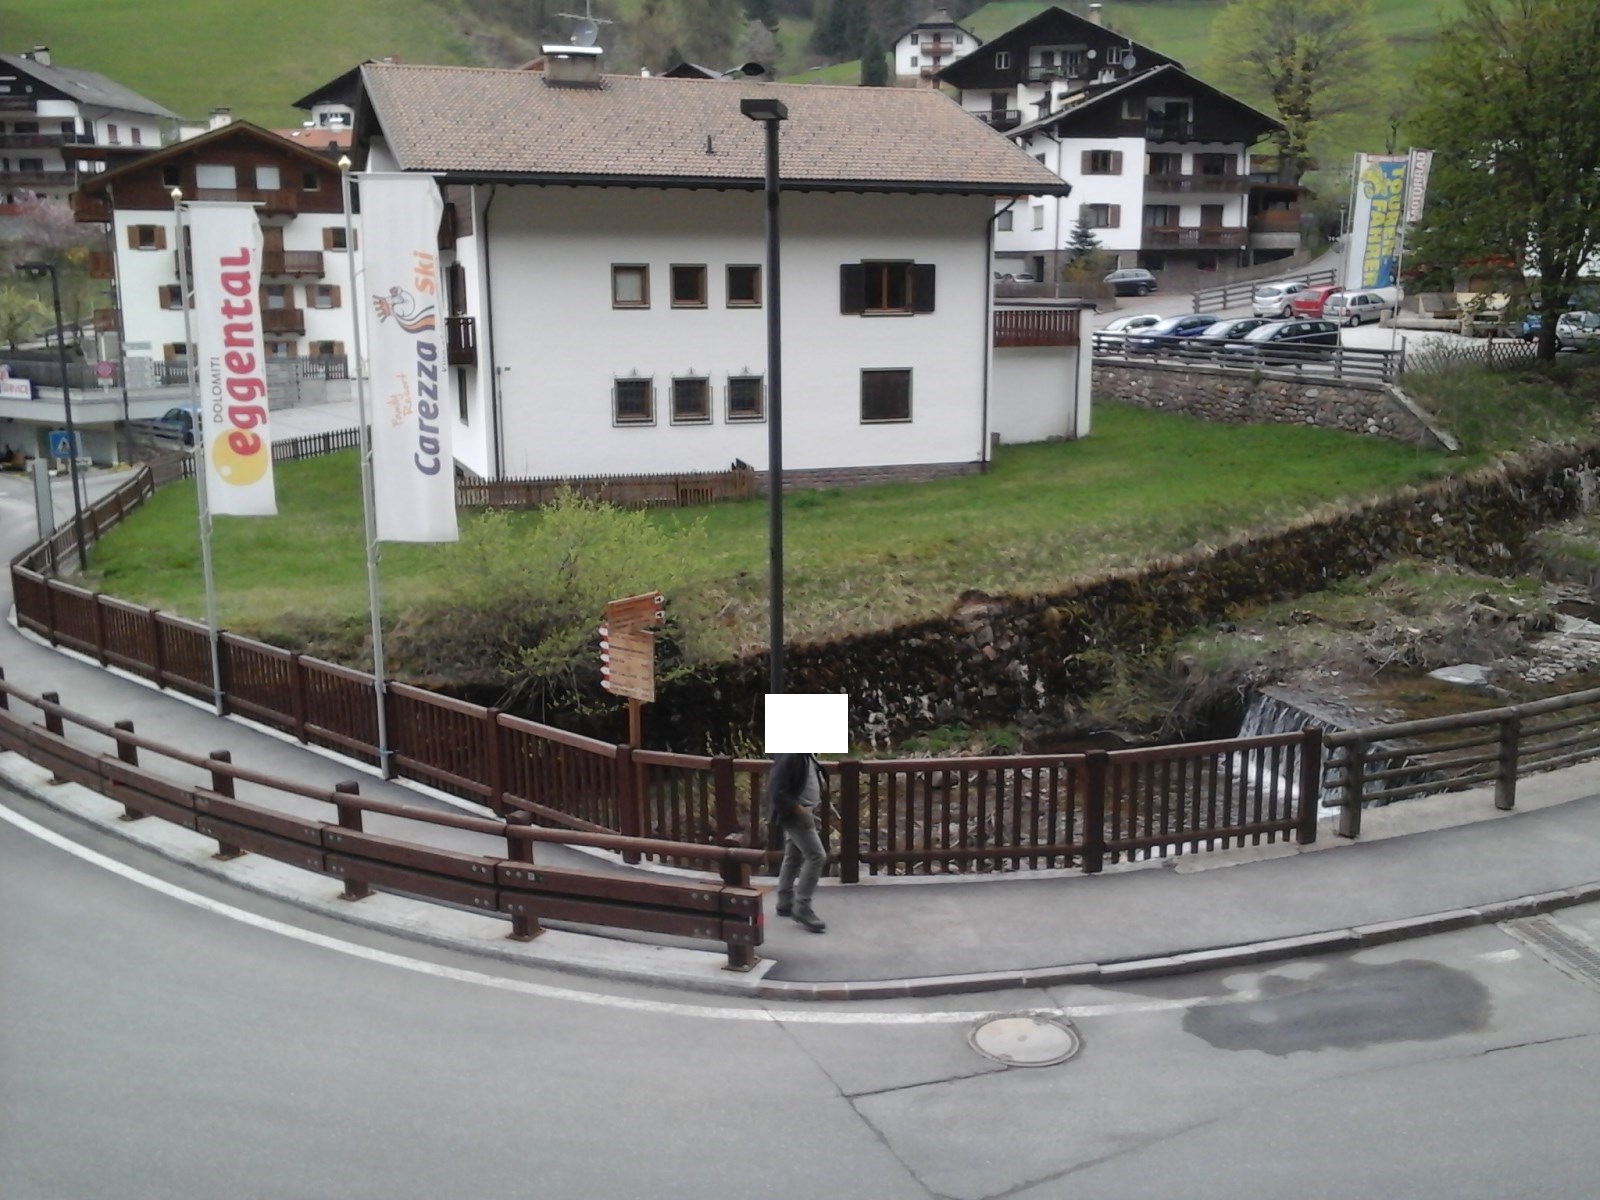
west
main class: Woodland
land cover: Spruce dominated coniferous woodland
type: alpine coniferous forest
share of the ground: > 75 %
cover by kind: coniferous forest trees 95 %, herbaceous plants 5 %
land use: Forestry
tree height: > 5 m
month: May
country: IT
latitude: 46.4301
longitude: 11.5467
